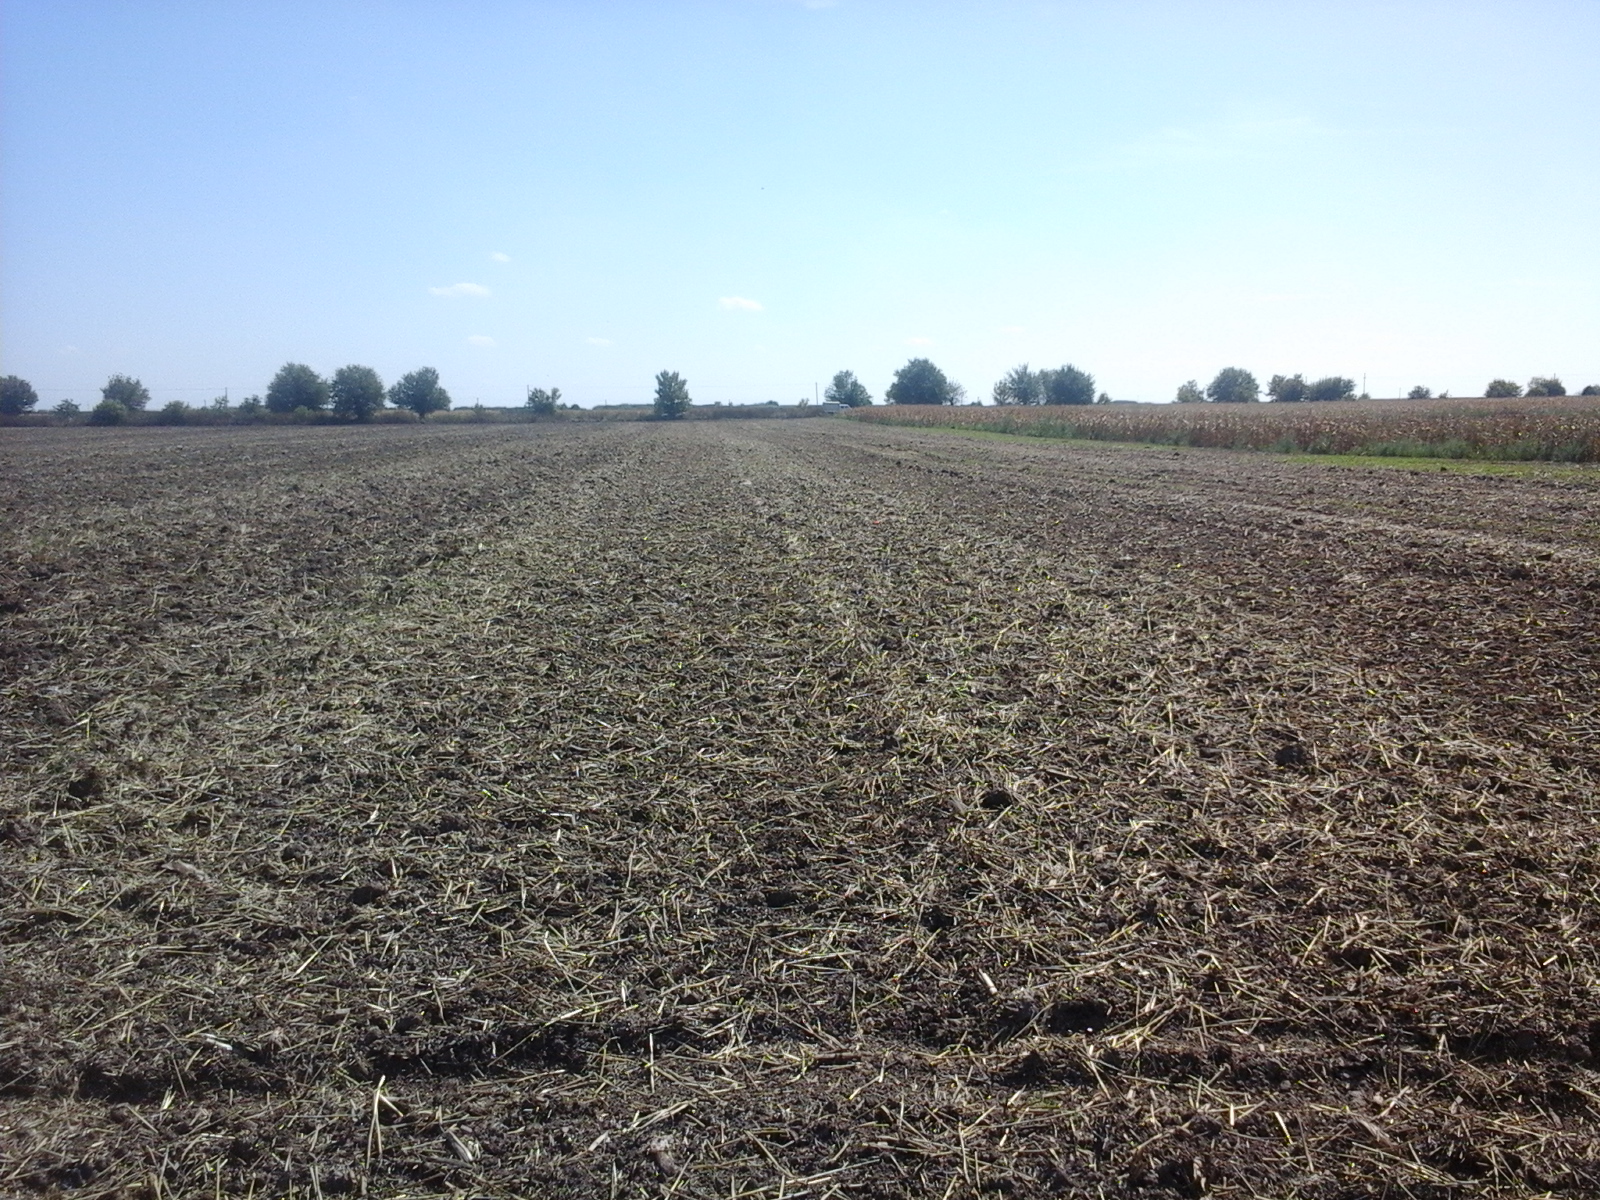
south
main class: Cropland
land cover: Common wheat
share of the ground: < 10 %
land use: Agriculture (excluding fallow land and kitchen gardens)
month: August
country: RO
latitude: 46.1272
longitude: 21.1751
